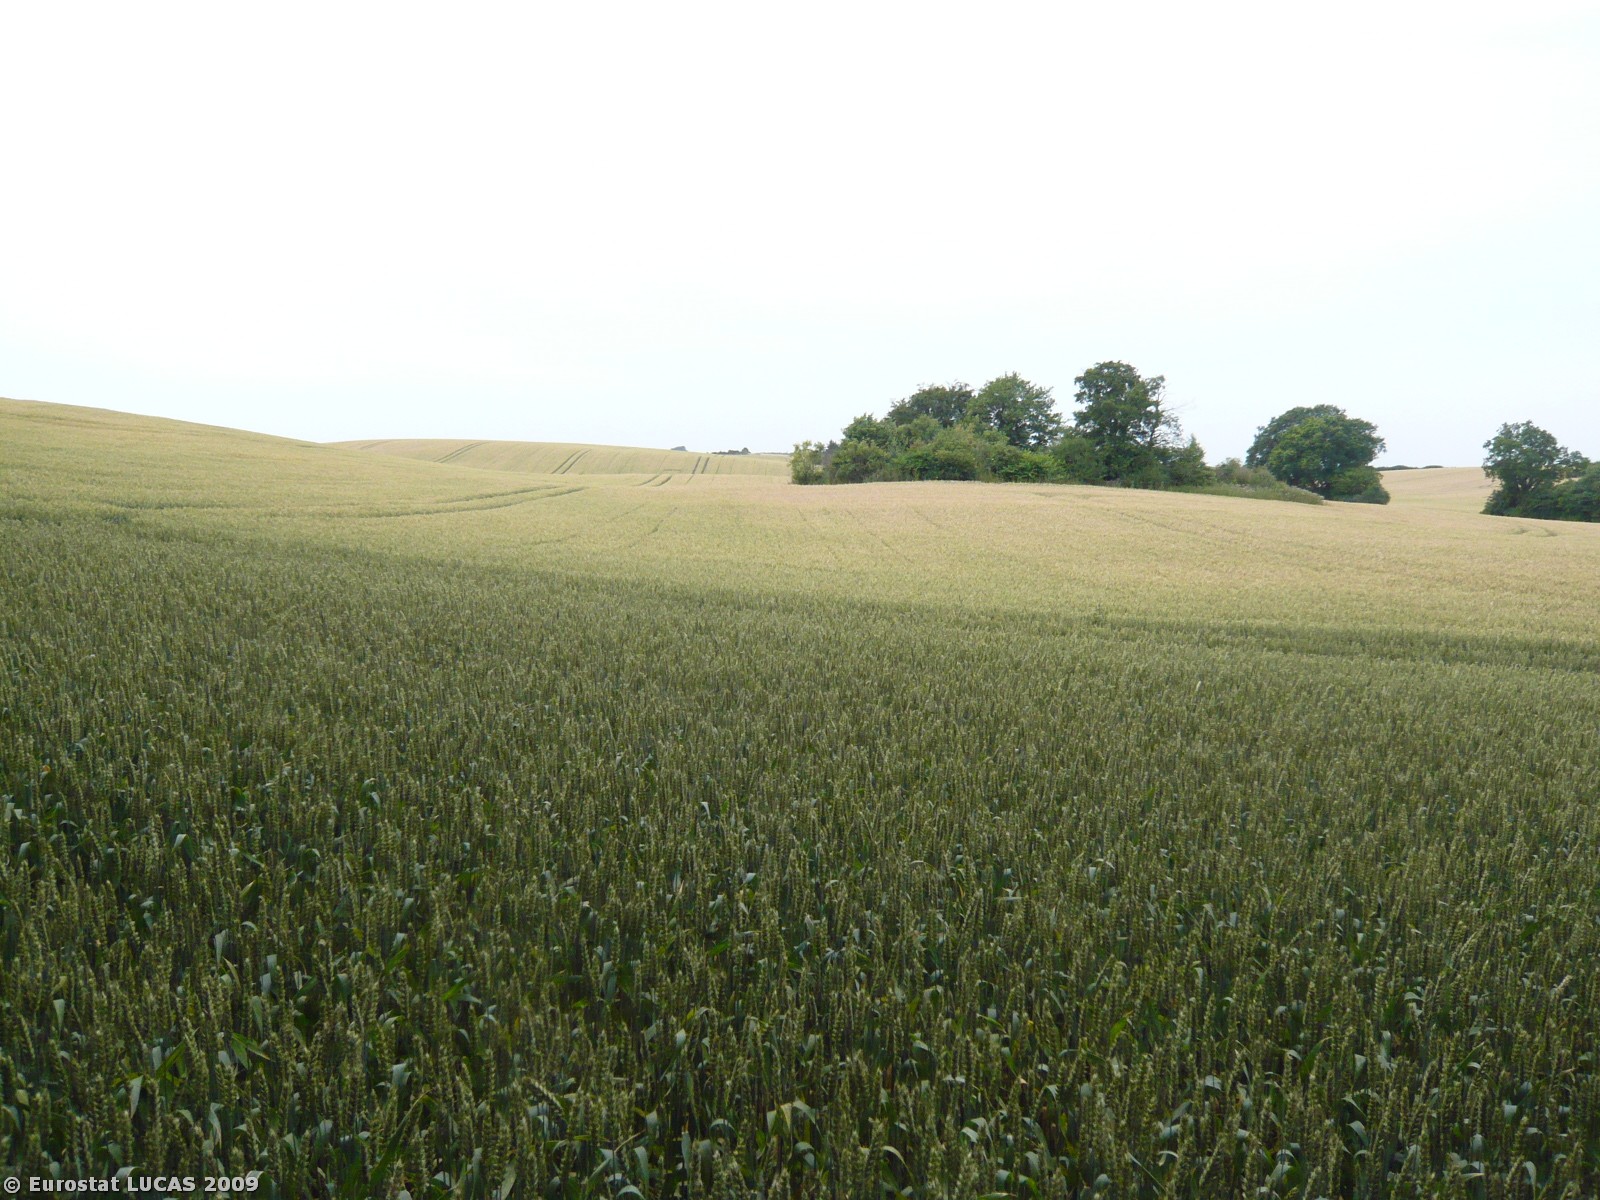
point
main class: Cropland
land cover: Common wheat
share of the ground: > 75 %
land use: Agriculture (excluding fallow land and kitchen gardens)
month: July
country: DK
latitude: 55.5293
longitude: 11.6937
